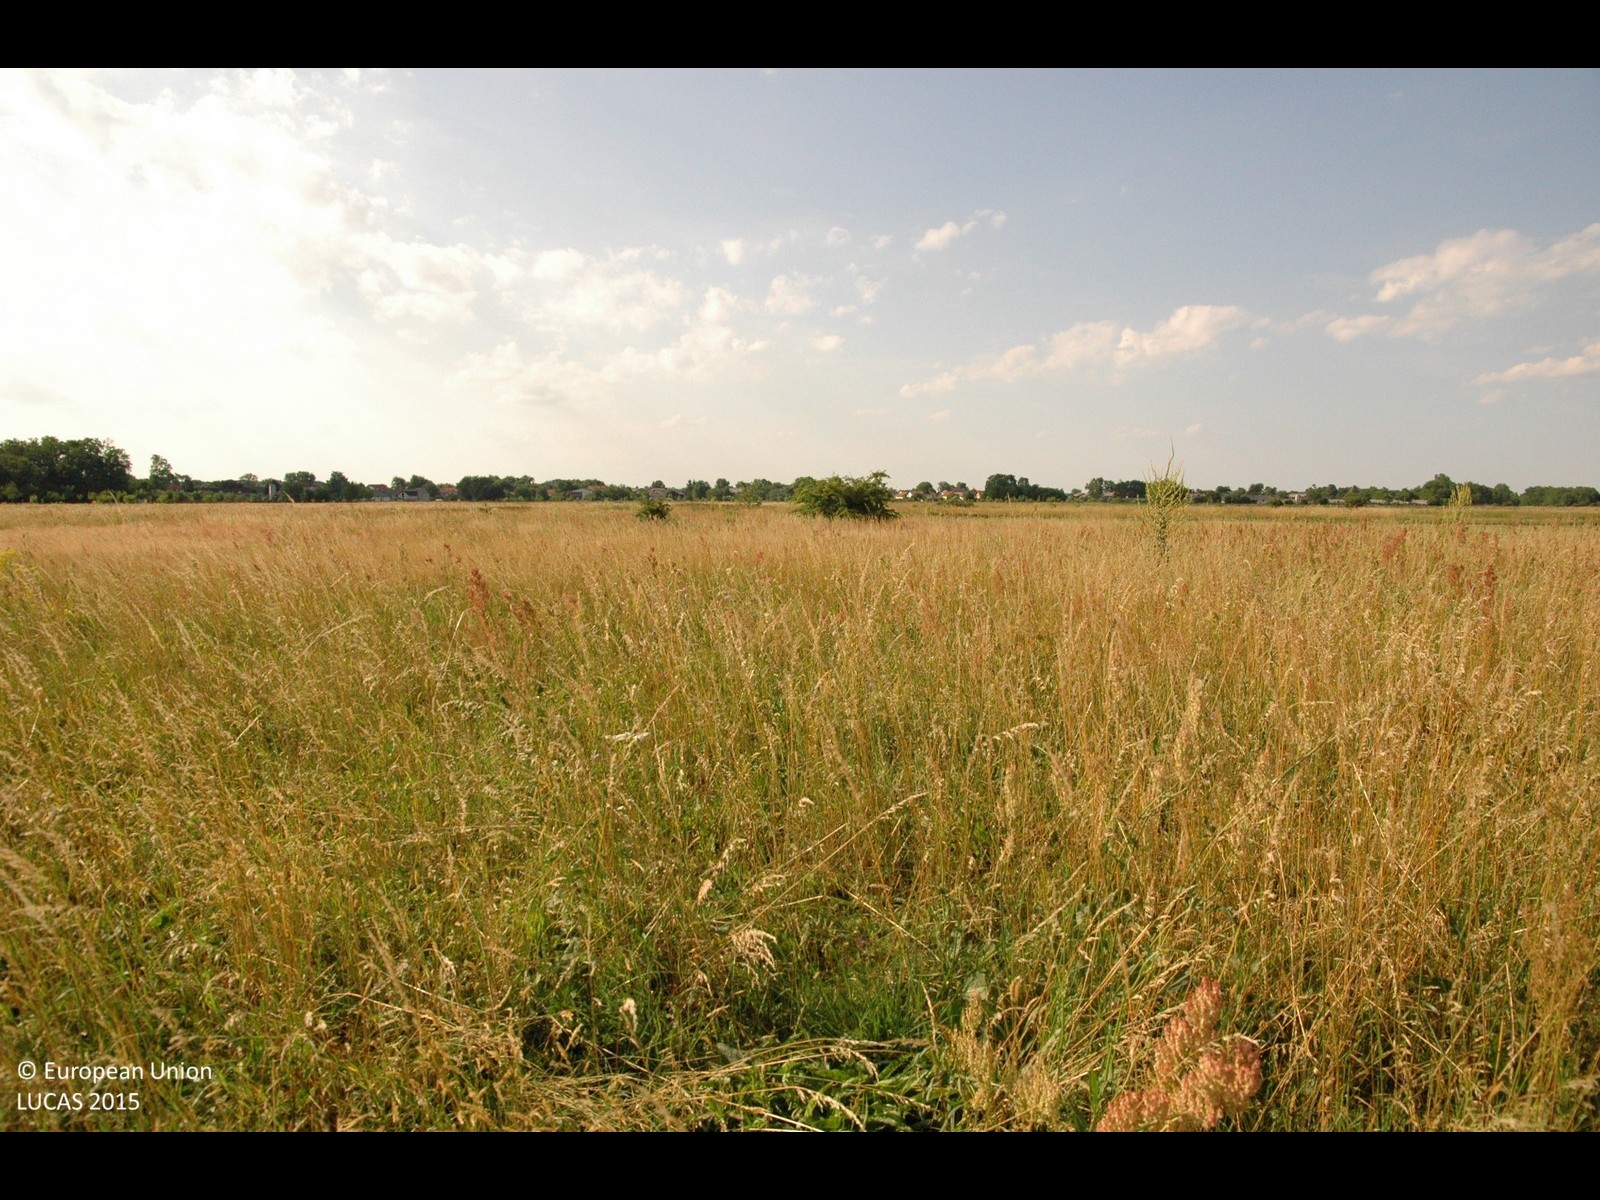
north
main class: Grassland
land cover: Grassland without tree/shrub cover
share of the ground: > 75 %
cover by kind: herbaceous plants 100 %
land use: Agriculture (excluding fallow land and kitchen gardens)
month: June
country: HR
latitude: 46.3890
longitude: 16.4897
